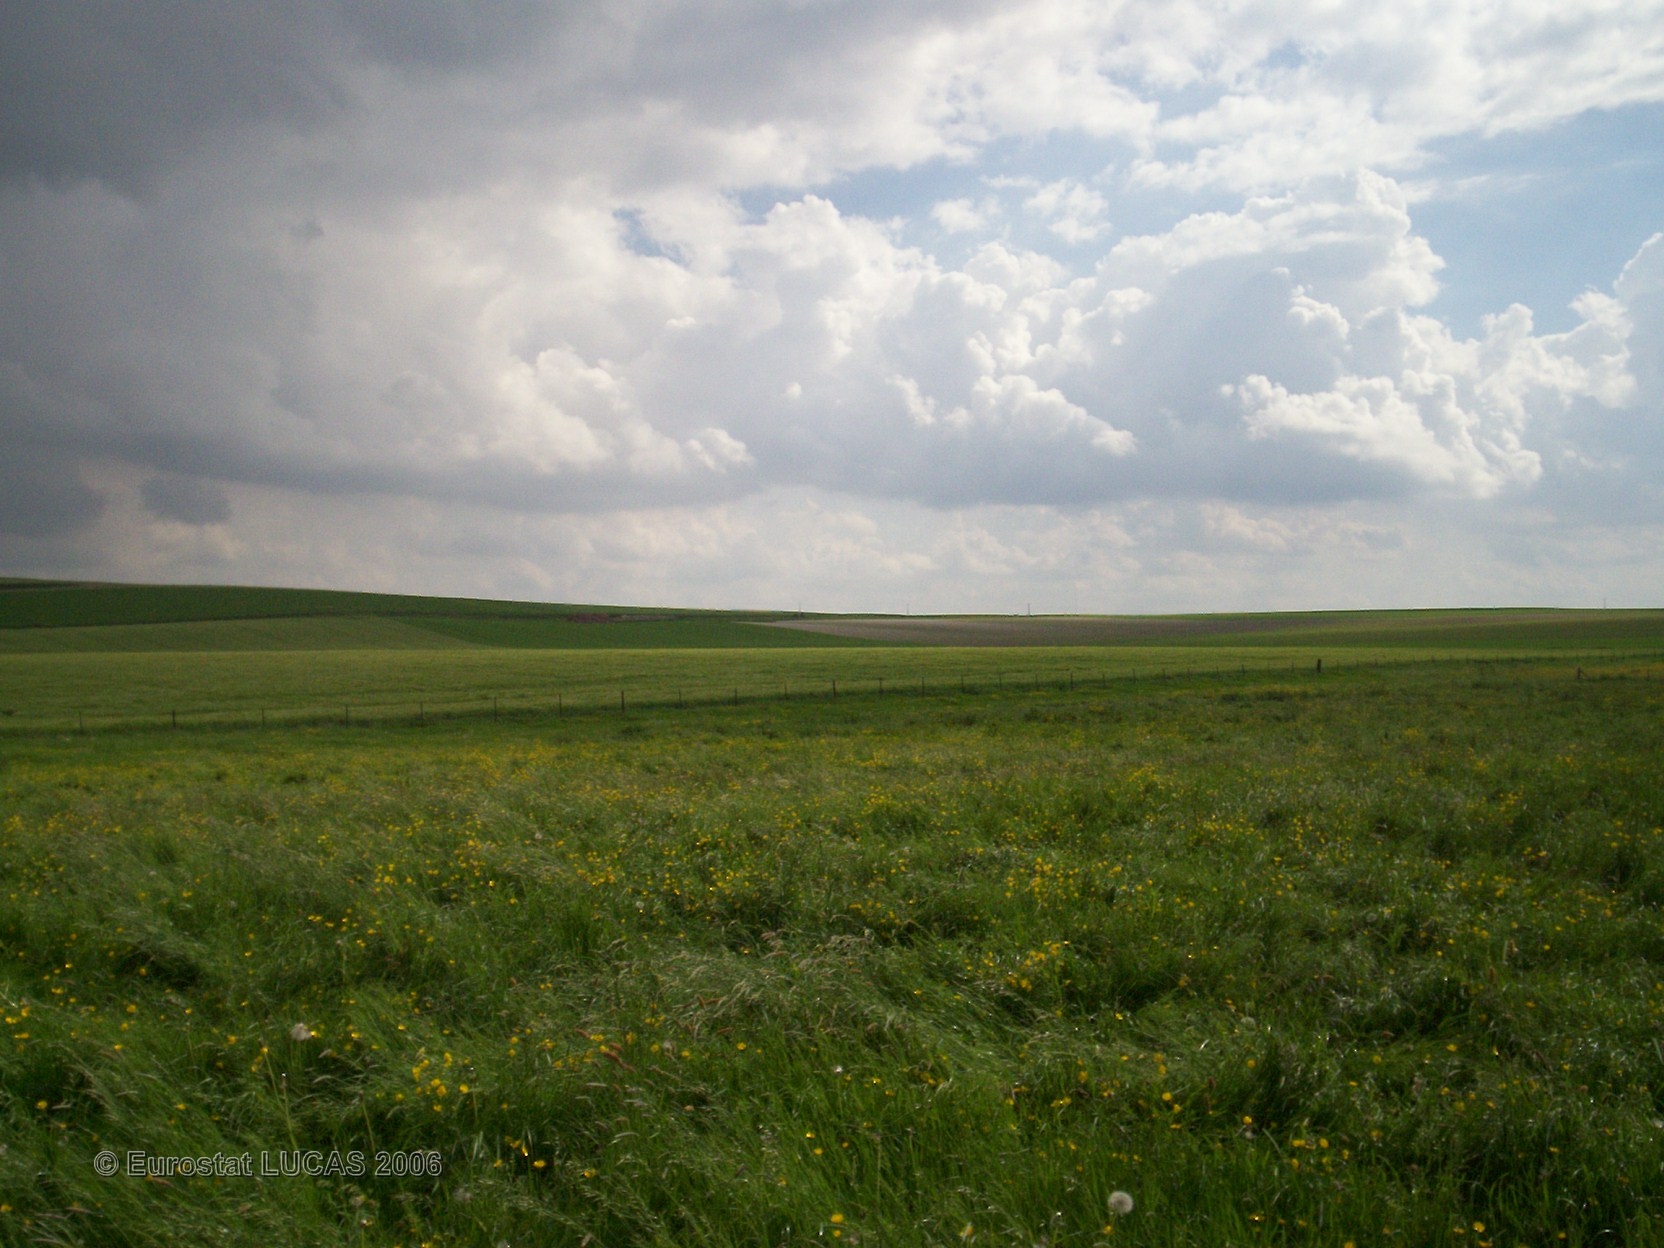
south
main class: Grassland
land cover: Grassland without tree/shrub cover
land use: Agriculture (excluding fallow land and kitchen gardens)
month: May
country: FR
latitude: 49.5570
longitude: 4.3417
